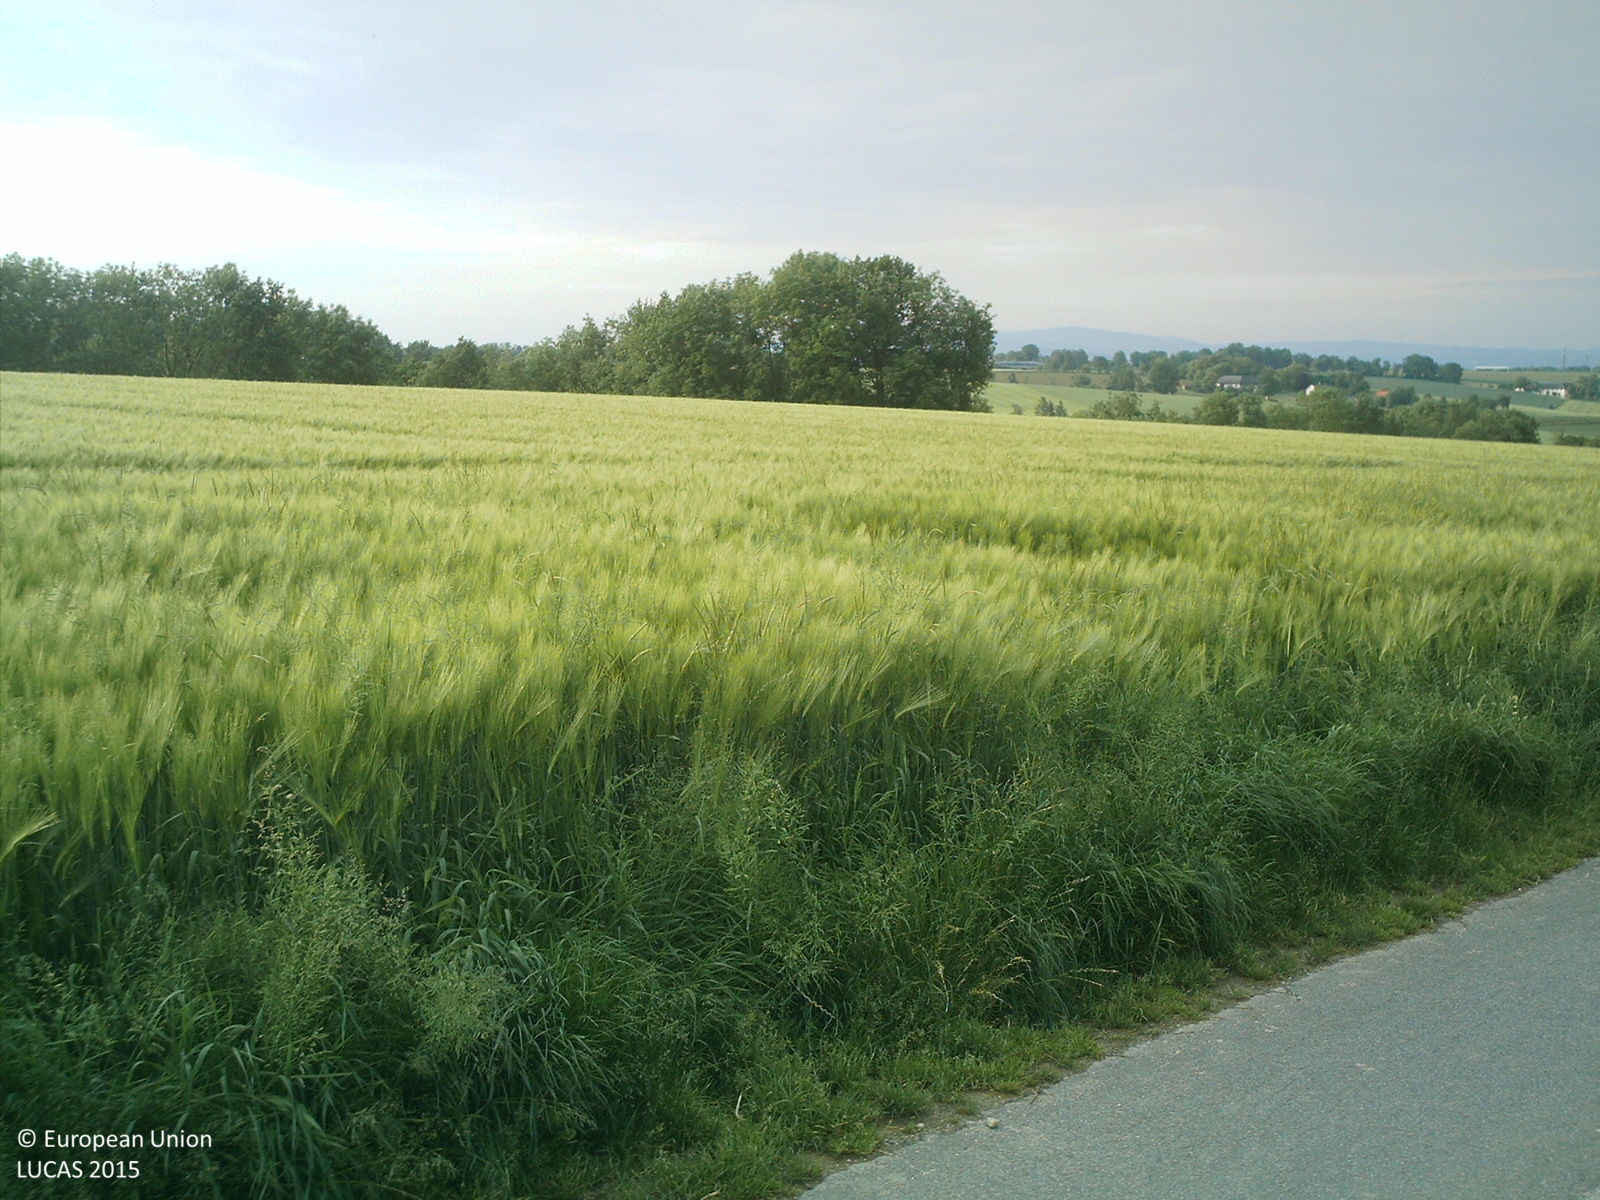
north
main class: Cropland
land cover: Barley
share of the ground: > 75 %
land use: Agriculture (excluding fallow land and kitchen gardens)
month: May
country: AT
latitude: 48.1623
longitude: 14.1811
